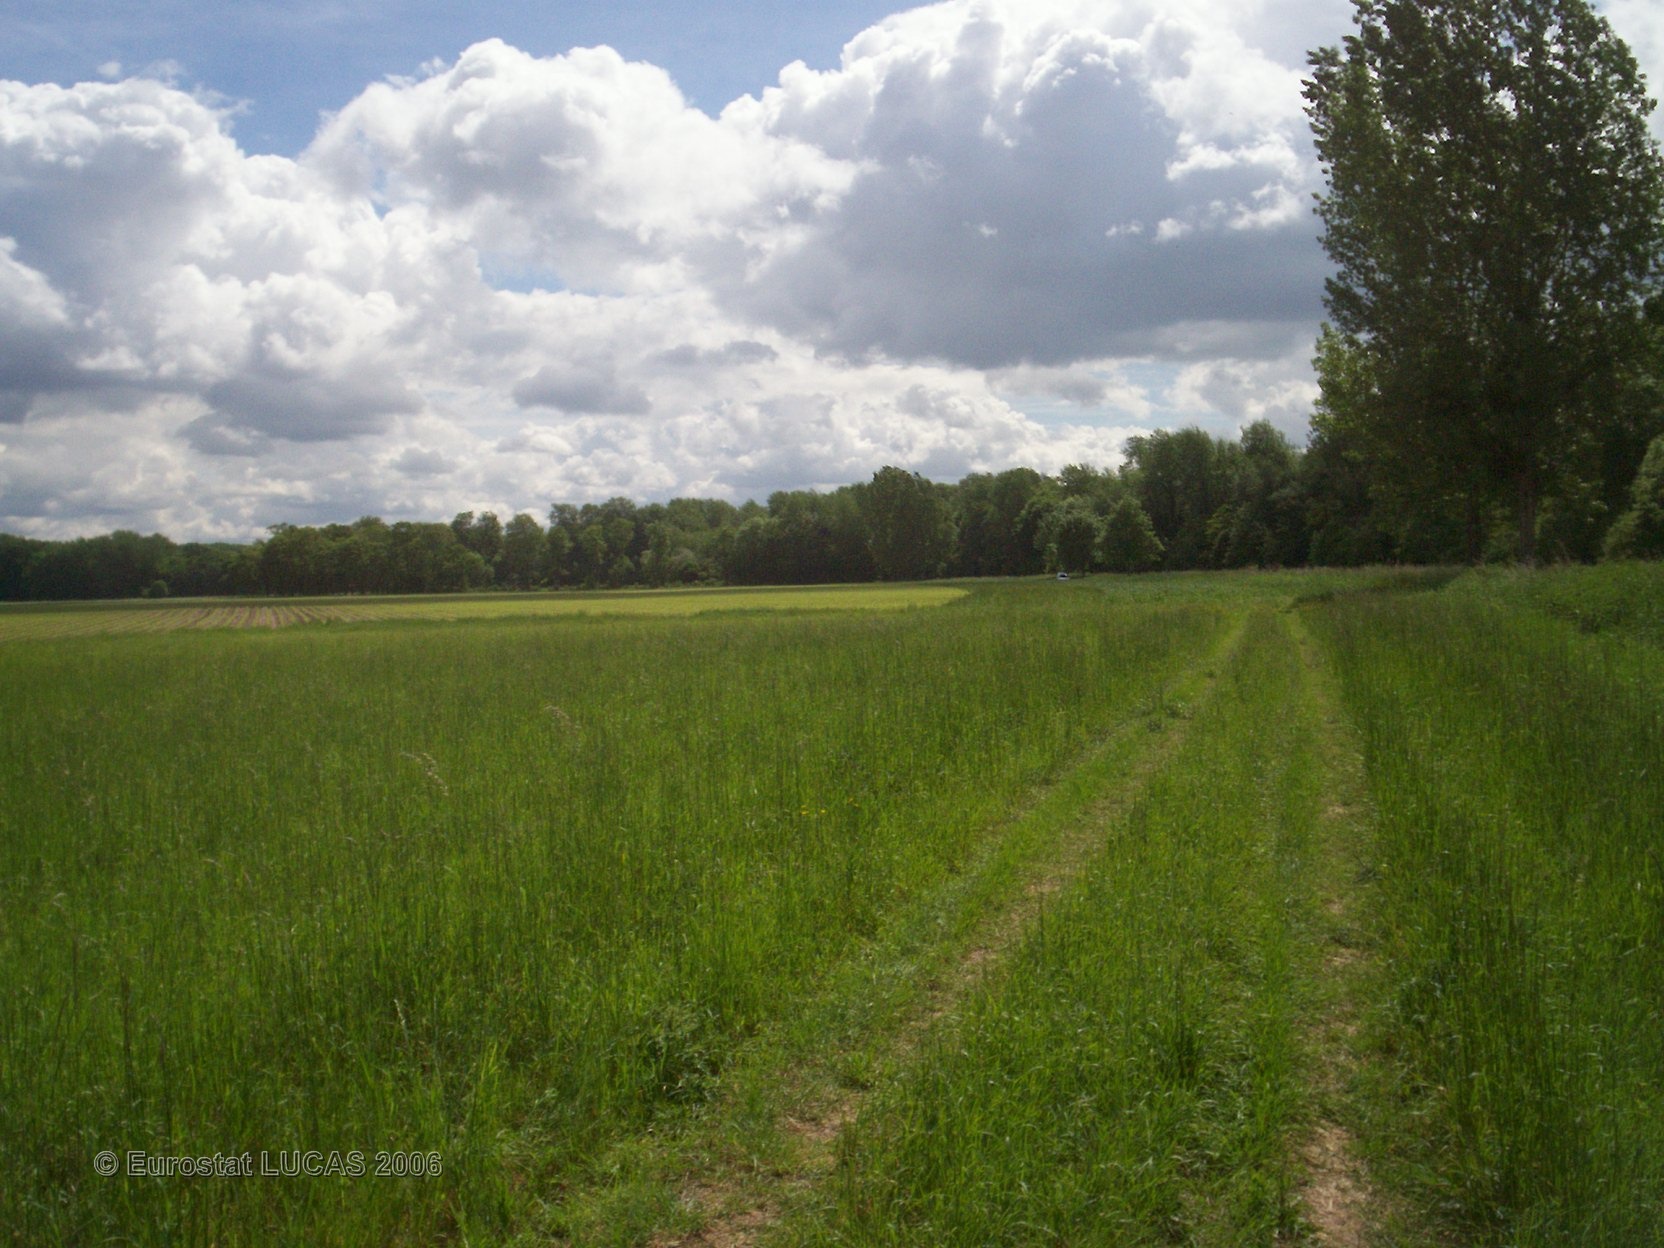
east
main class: Grassland
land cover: Grassland without tree/shrub cover
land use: Agriculture (excluding fallow land and kitchen gardens)
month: May
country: FR
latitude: 49.4881
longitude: 4.4051
